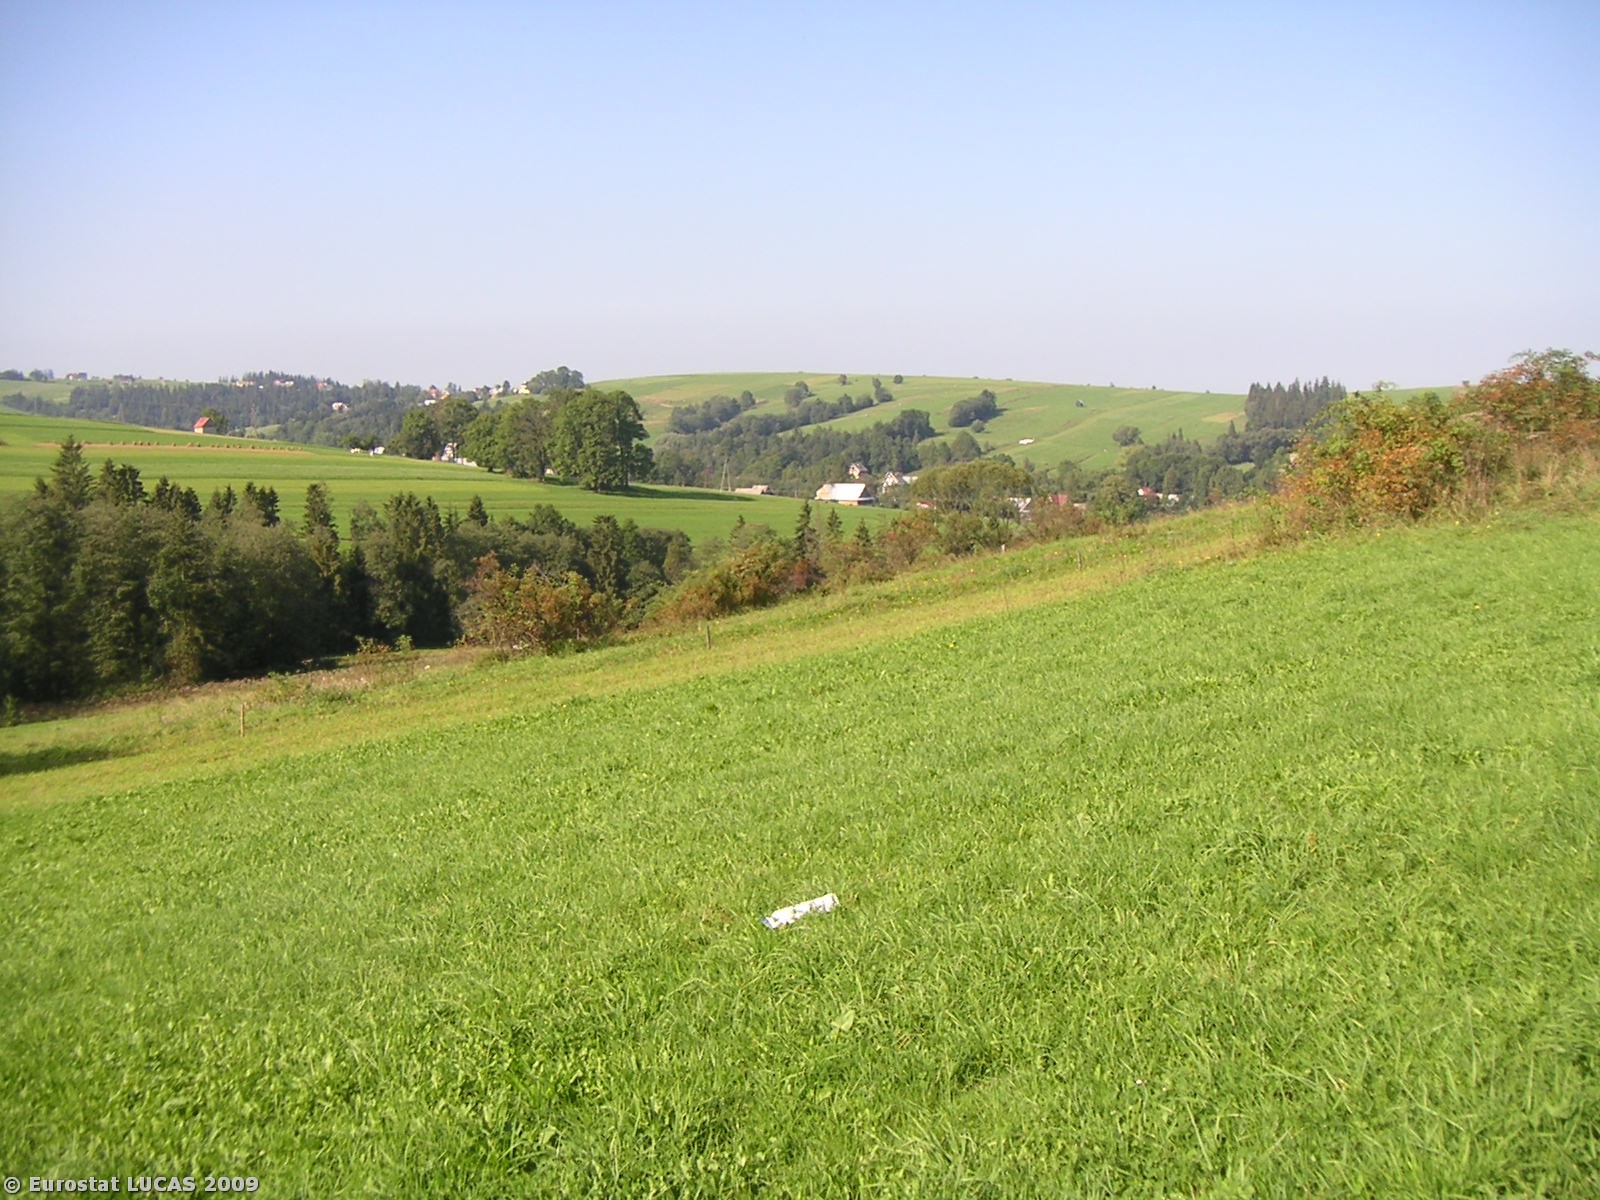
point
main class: Grassland
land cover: Grassland without tree/shrub cover
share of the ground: > 75 %
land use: Agriculture (excluding fallow land and kitchen gardens)
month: September
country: PL
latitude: 49.4102
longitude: 20.0798
